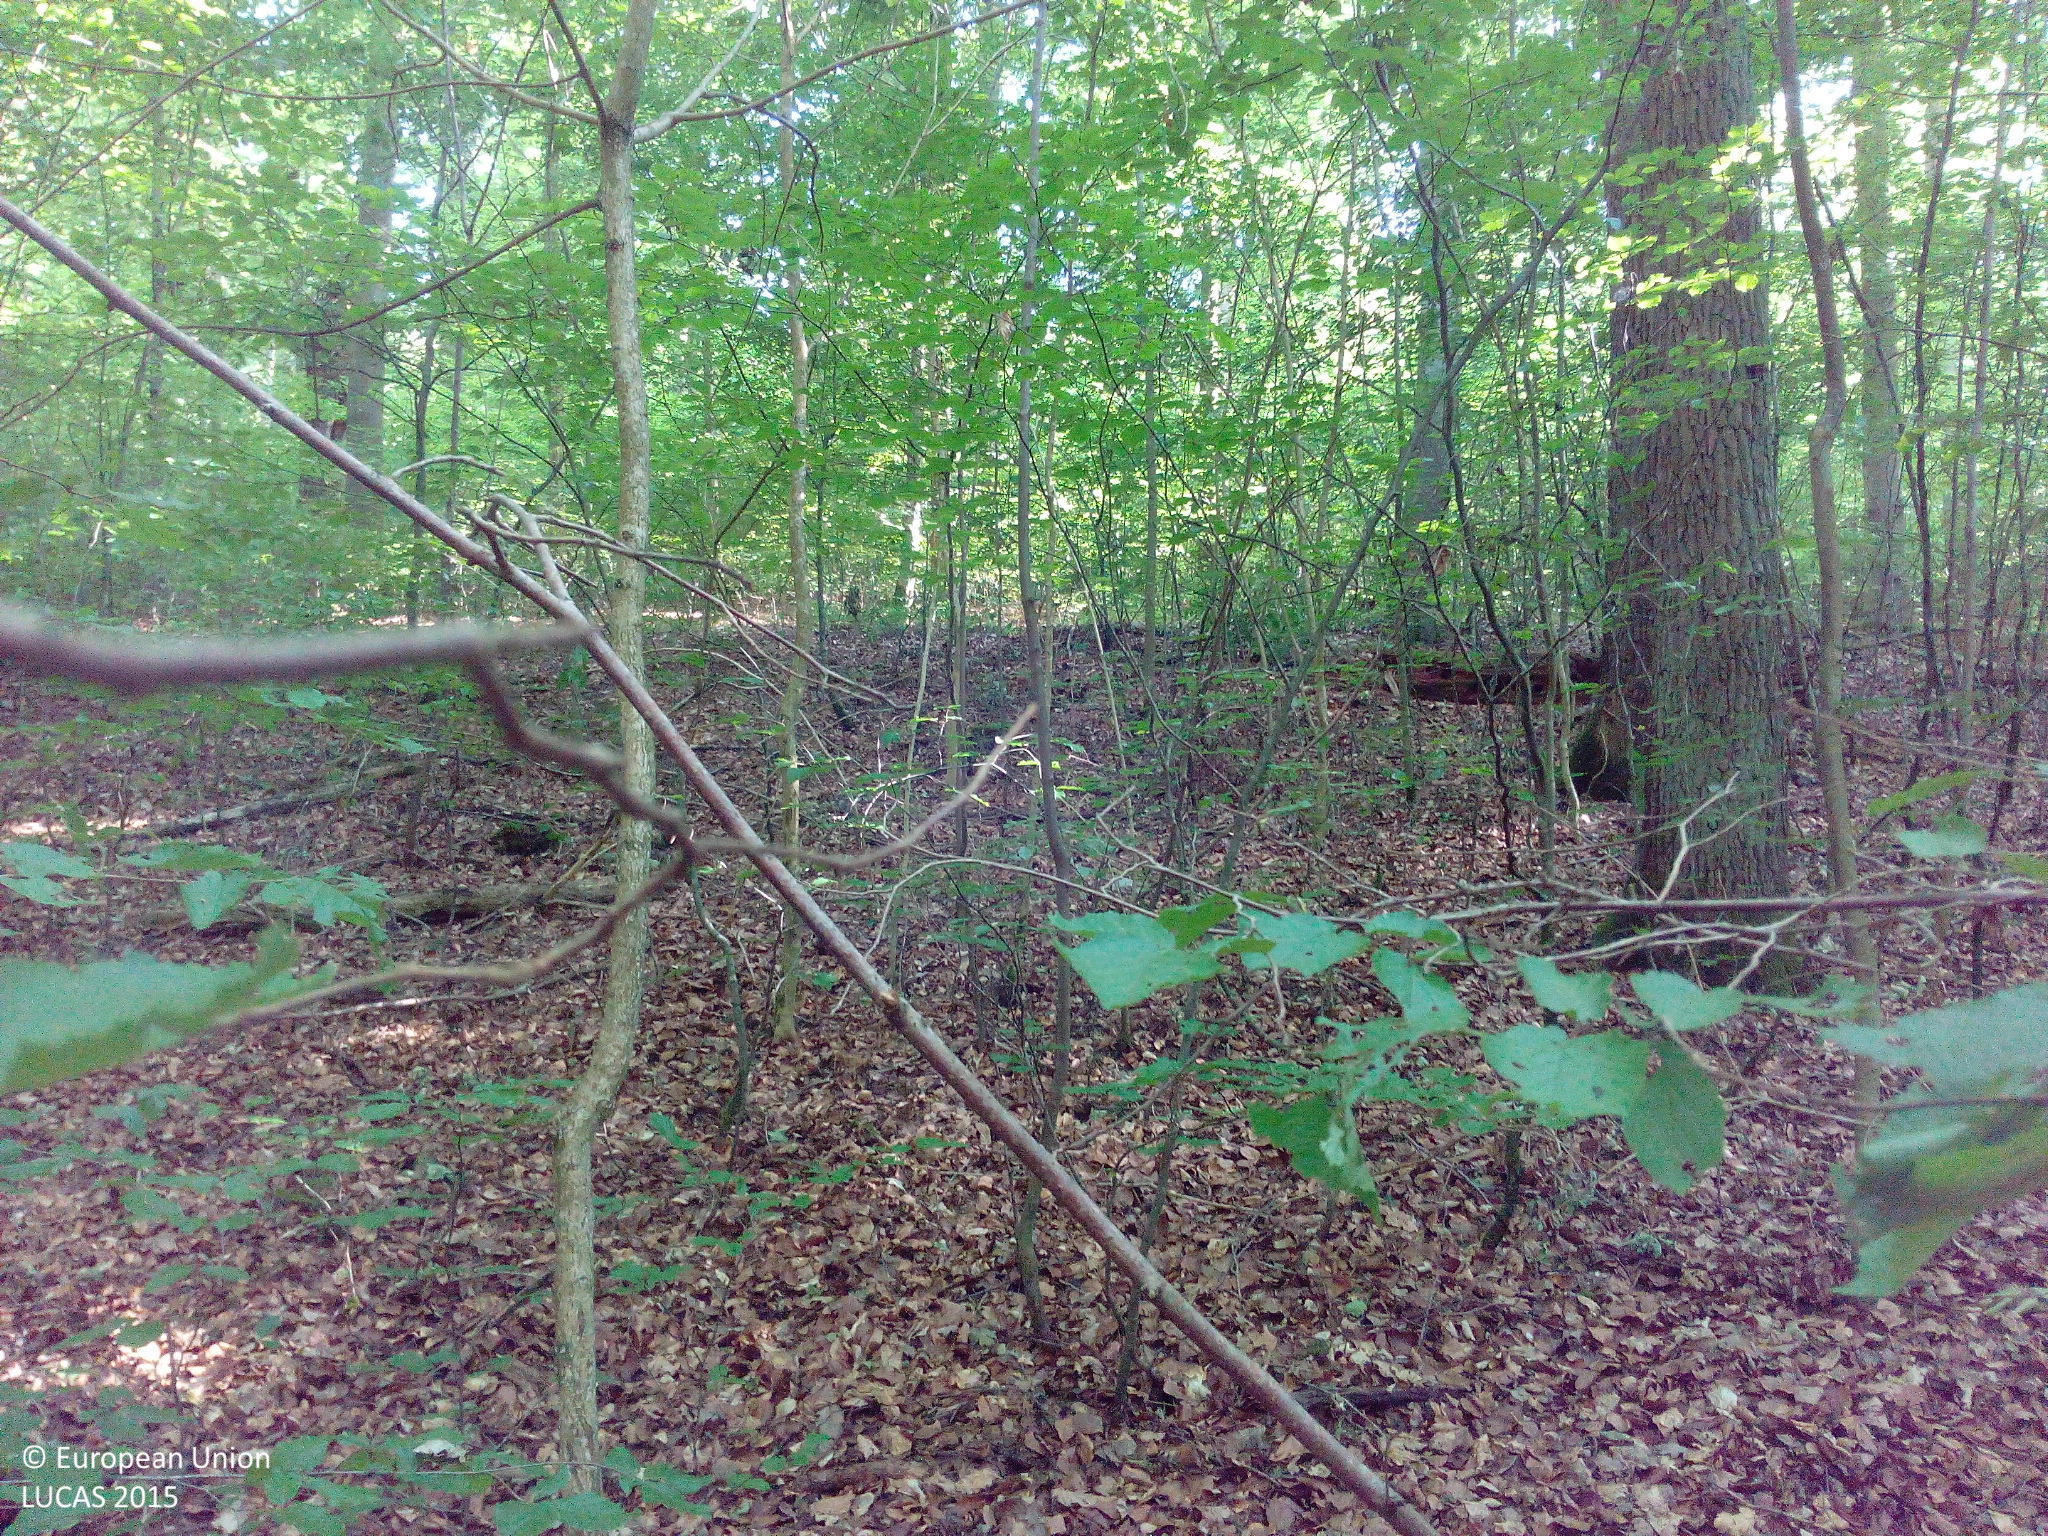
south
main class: Woodland
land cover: Broadleaved woodland
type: mesophytic deciduous forest
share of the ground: > 75 %
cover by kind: broadleaved forest trees 100 %
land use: Forestry
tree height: > 5 m
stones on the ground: < 10 %
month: July
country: DE
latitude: 49.7706
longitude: 9.9028
